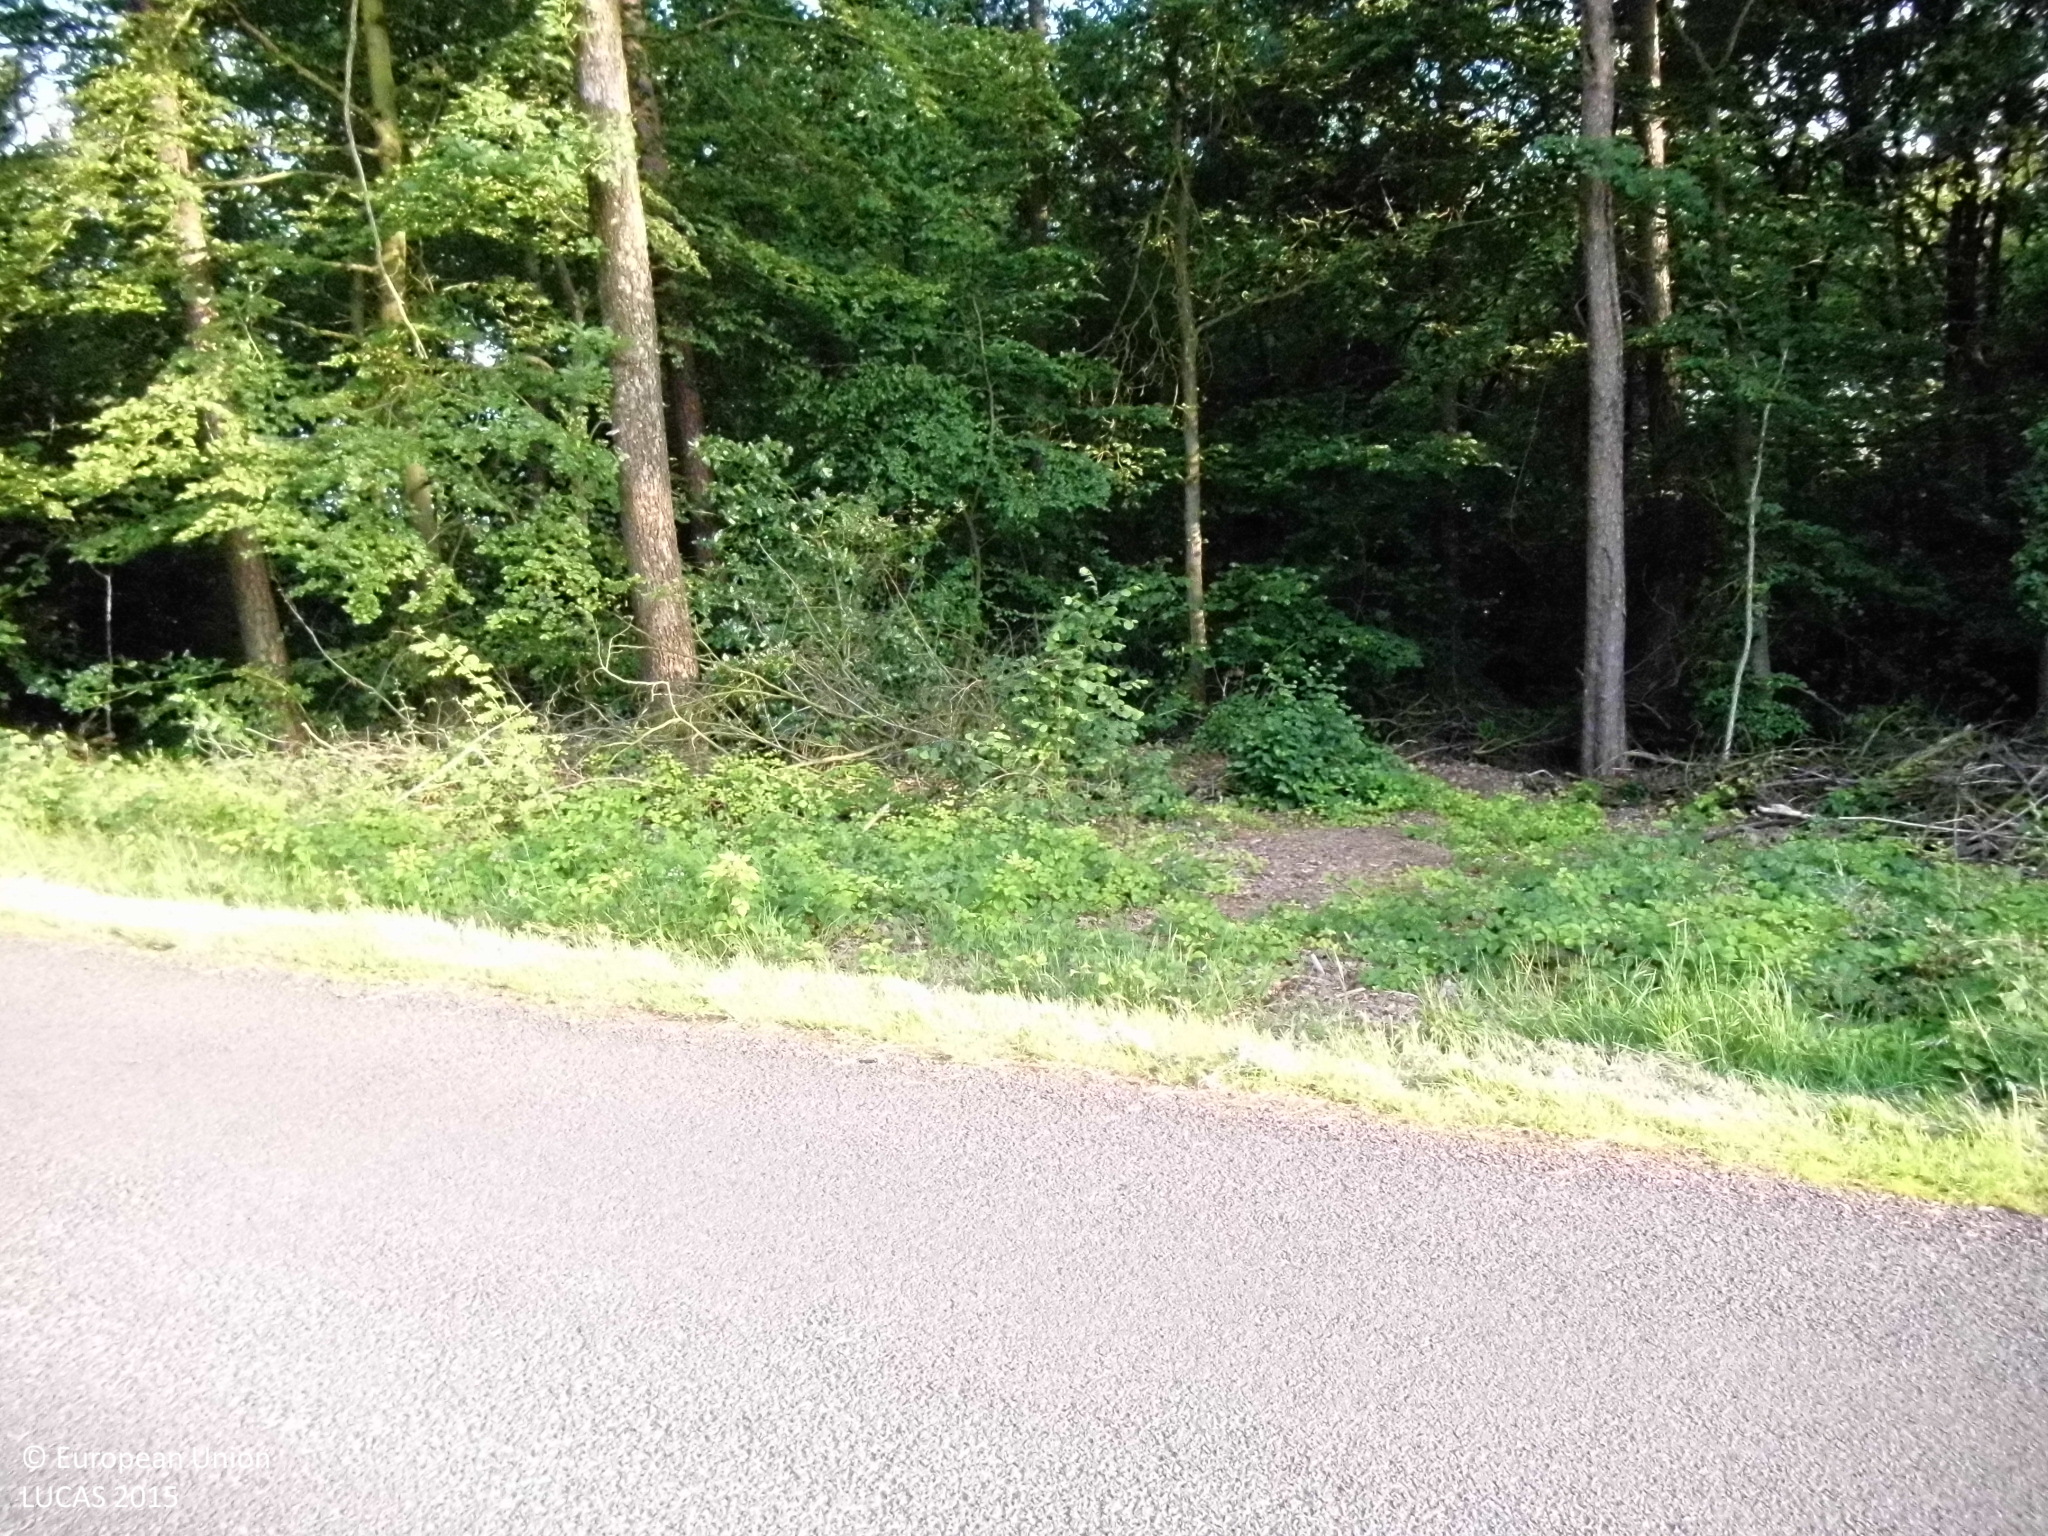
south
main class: Woodland
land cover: Broadleaved woodland
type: mesophytic deciduous forest
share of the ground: > 75 %
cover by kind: broadleaved forest trees 100 %
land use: Forestry
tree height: > 5 m
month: June
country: DE
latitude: 50.8222
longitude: 7.4876
